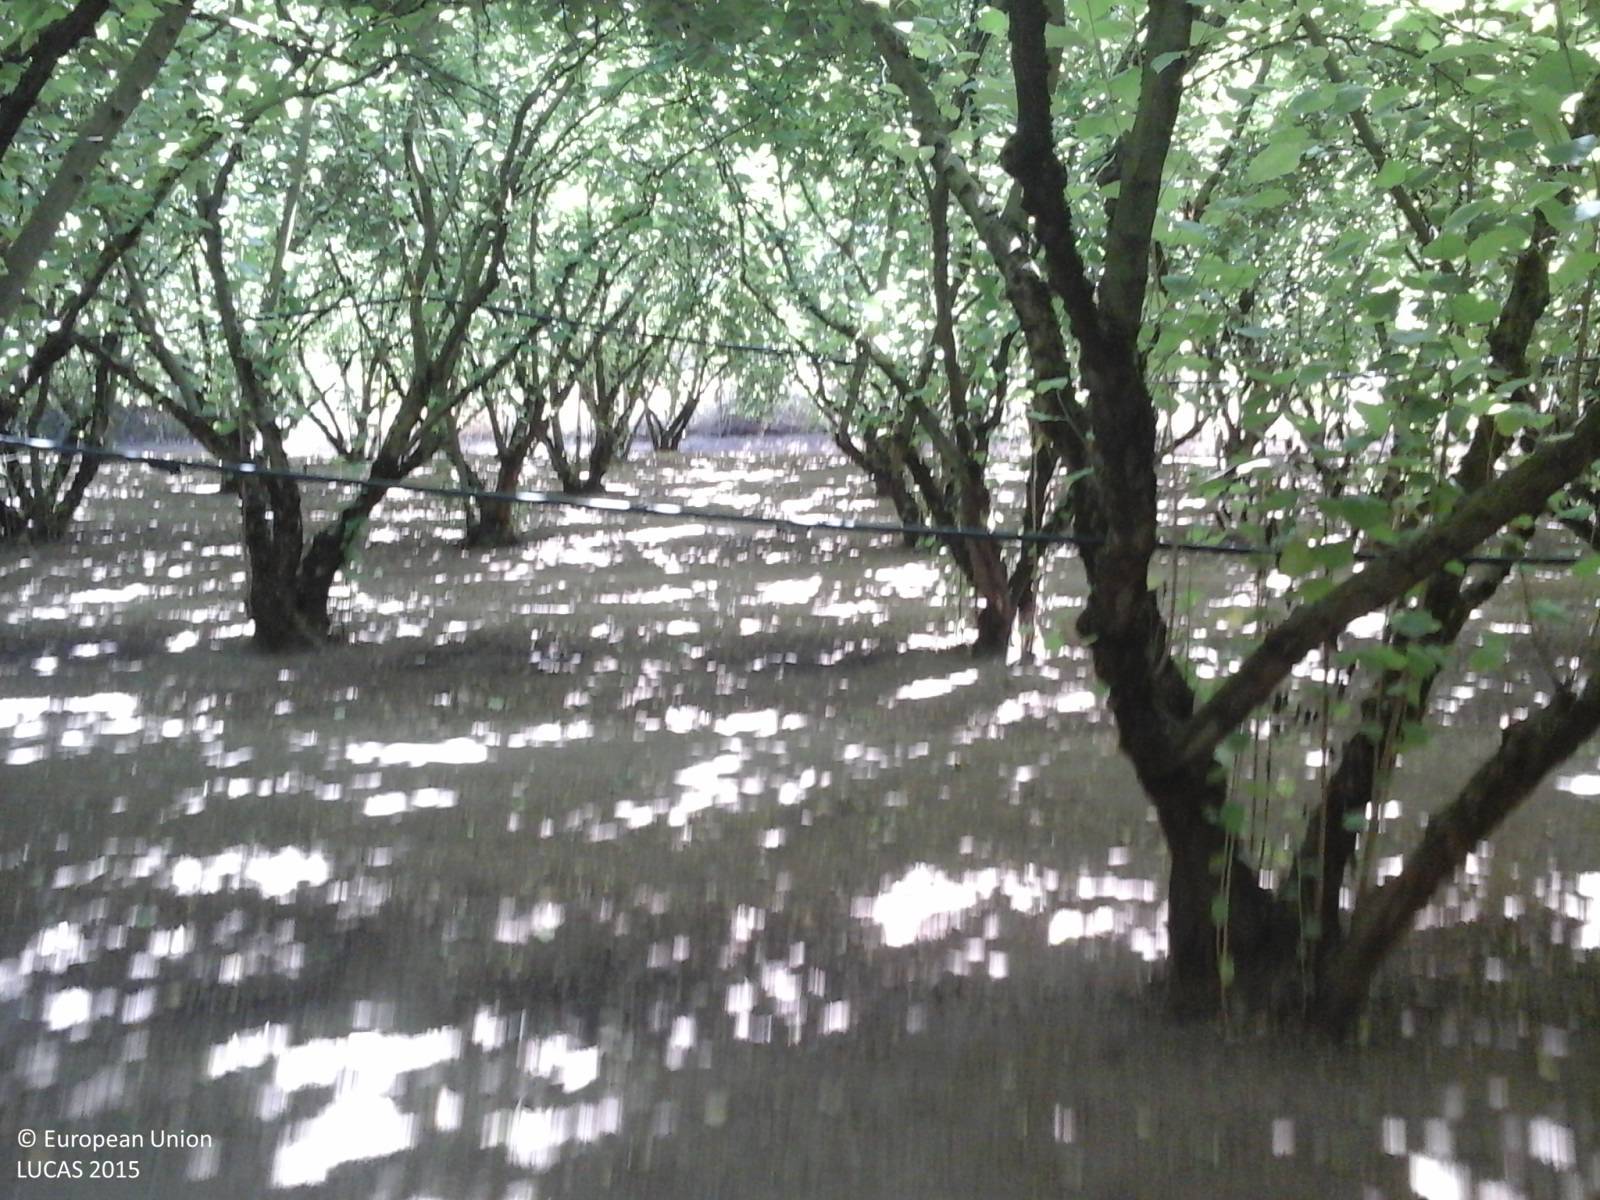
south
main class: Cropland
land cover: Nuts trees
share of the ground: > 75 %
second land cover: Other bare soil
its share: > 75 %
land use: Agriculture (excluding fallow land and kitchen gardens)
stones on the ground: < 10 %
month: July
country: IT
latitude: 42.2844
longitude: 12.3082
